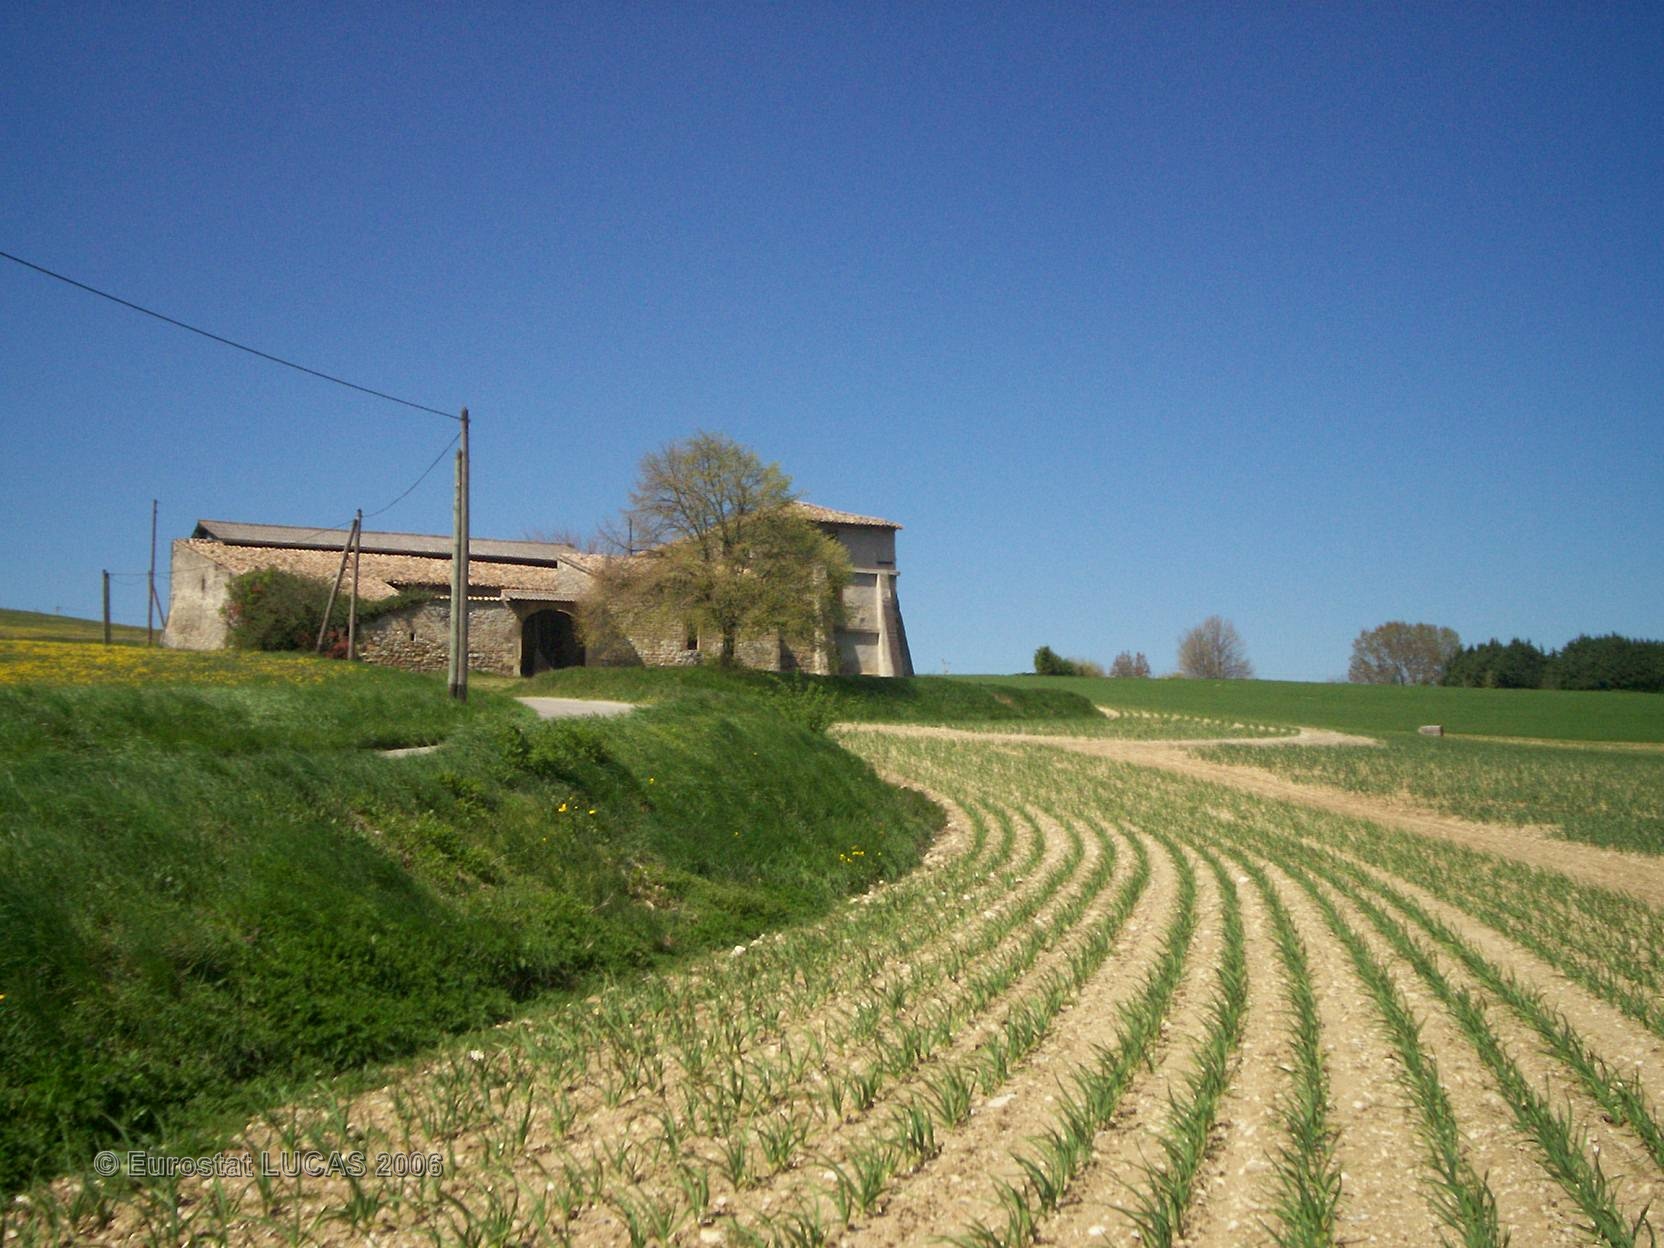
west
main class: Cropland
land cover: Other fresh vegetables
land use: Agriculture (excluding fallow land and kitchen gardens)
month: April
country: FR
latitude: 44.7319
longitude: 4.9176
